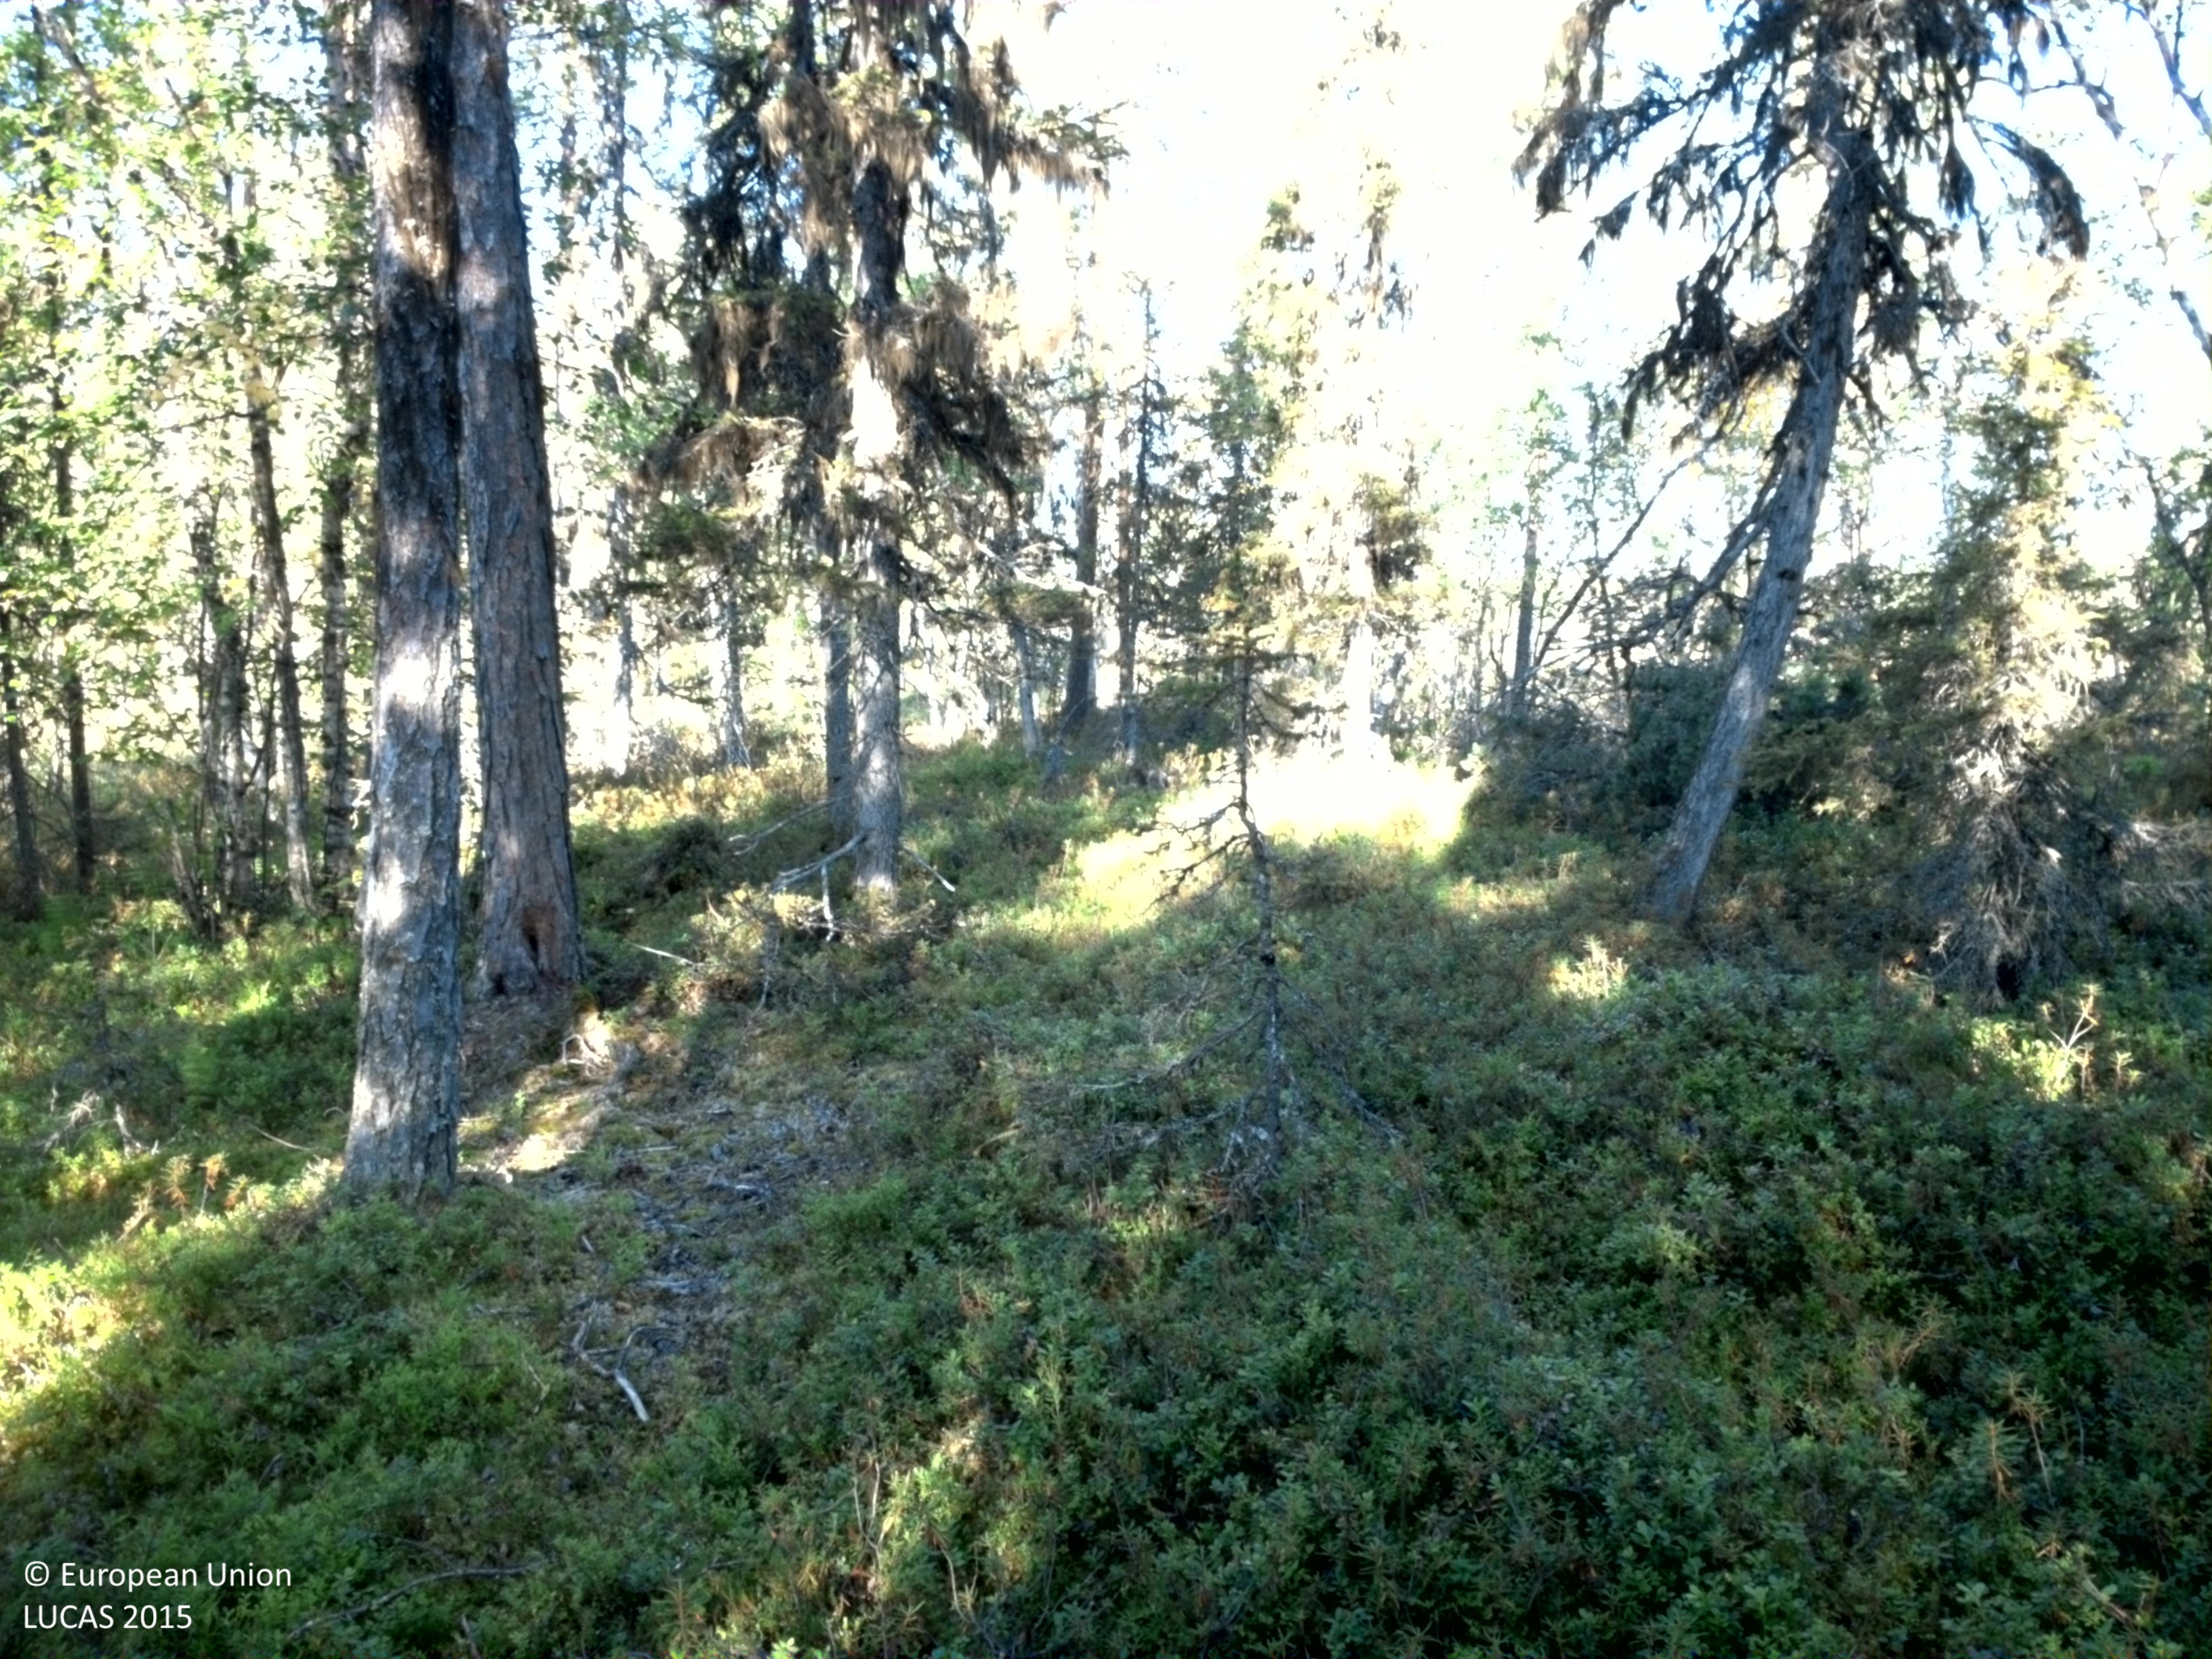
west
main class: Woodland
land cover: Spruce dominated coniferous woodland
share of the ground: 25 - 50 %
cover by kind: shrubs 65 %, coniferous forest trees 30 %, broadleaved forest trees 5 %
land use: Forestry
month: August
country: SE
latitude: 66.6340
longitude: 20.0529
